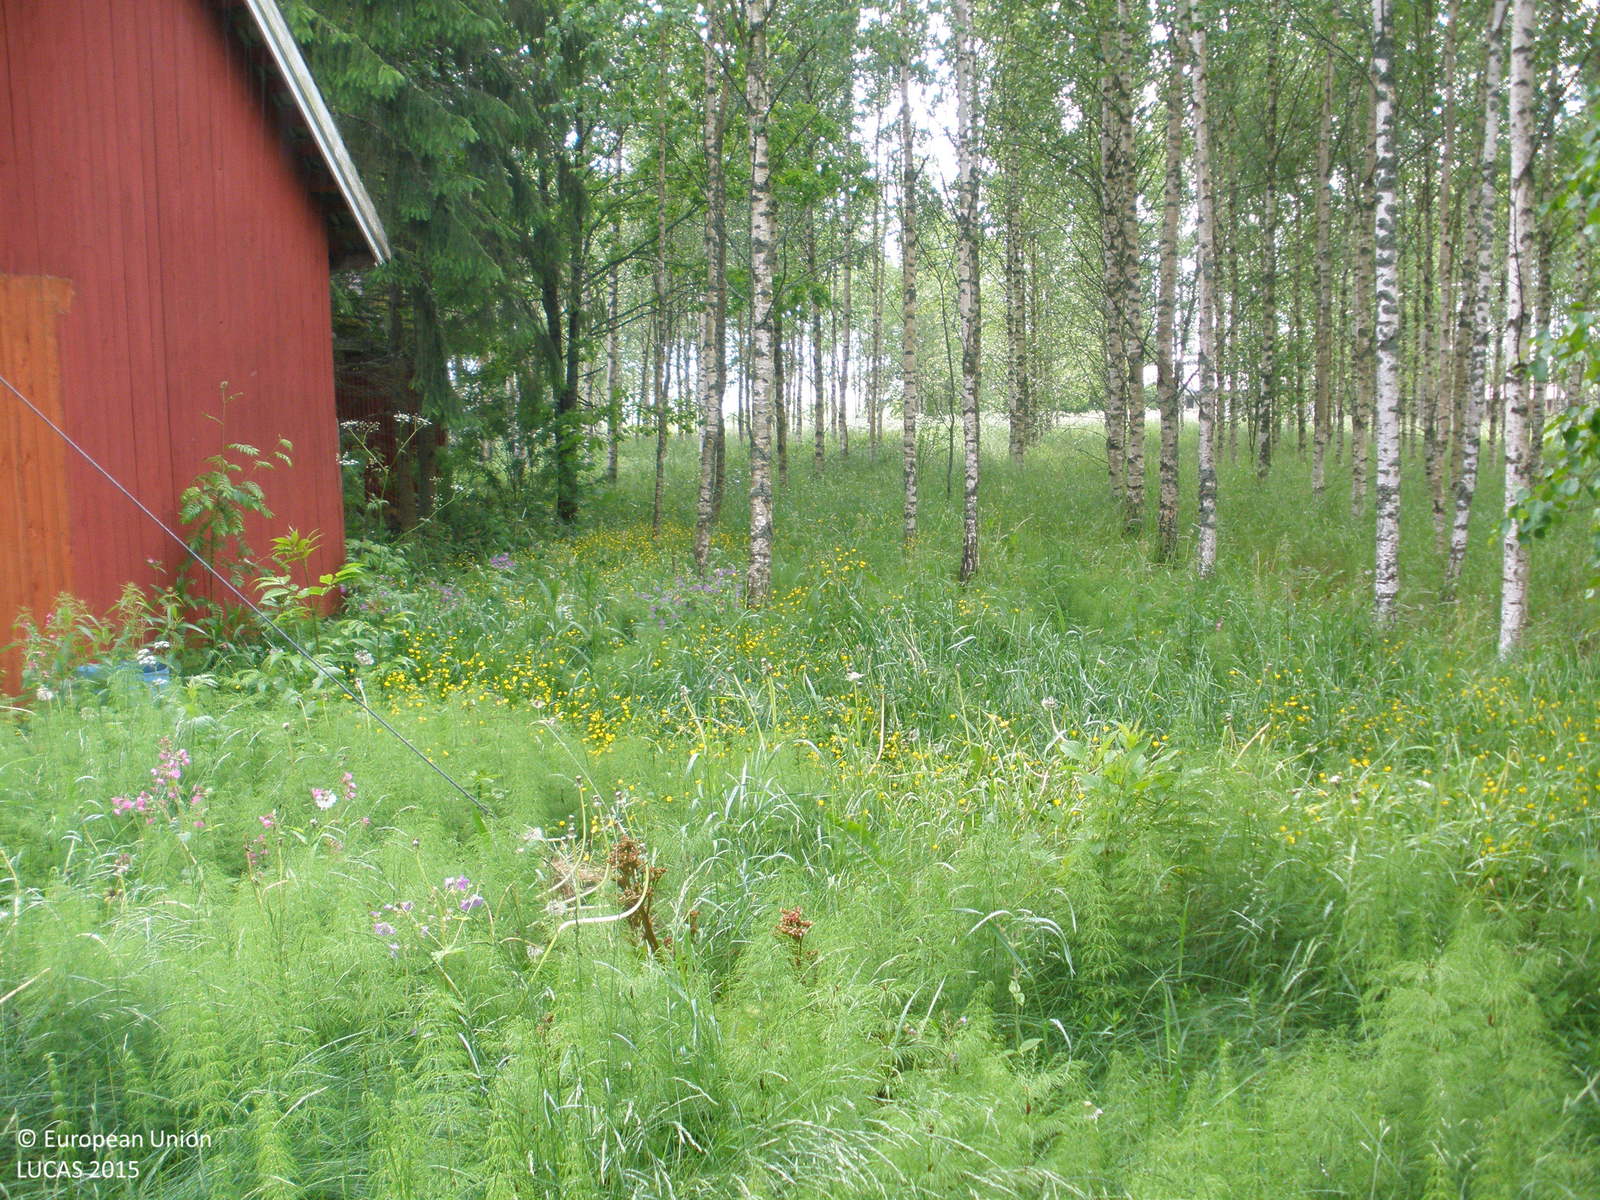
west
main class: Woodland
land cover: Broadleaved woodland
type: non-riverine alder, birch or aspen forest
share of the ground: > 75 %
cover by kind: broadleaved forest trees 80 %, herbaceous plants 15 %, shrubs 5 %
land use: Forestry
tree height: > 5 m
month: June
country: FI
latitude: 60.8847
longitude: 23.4779
